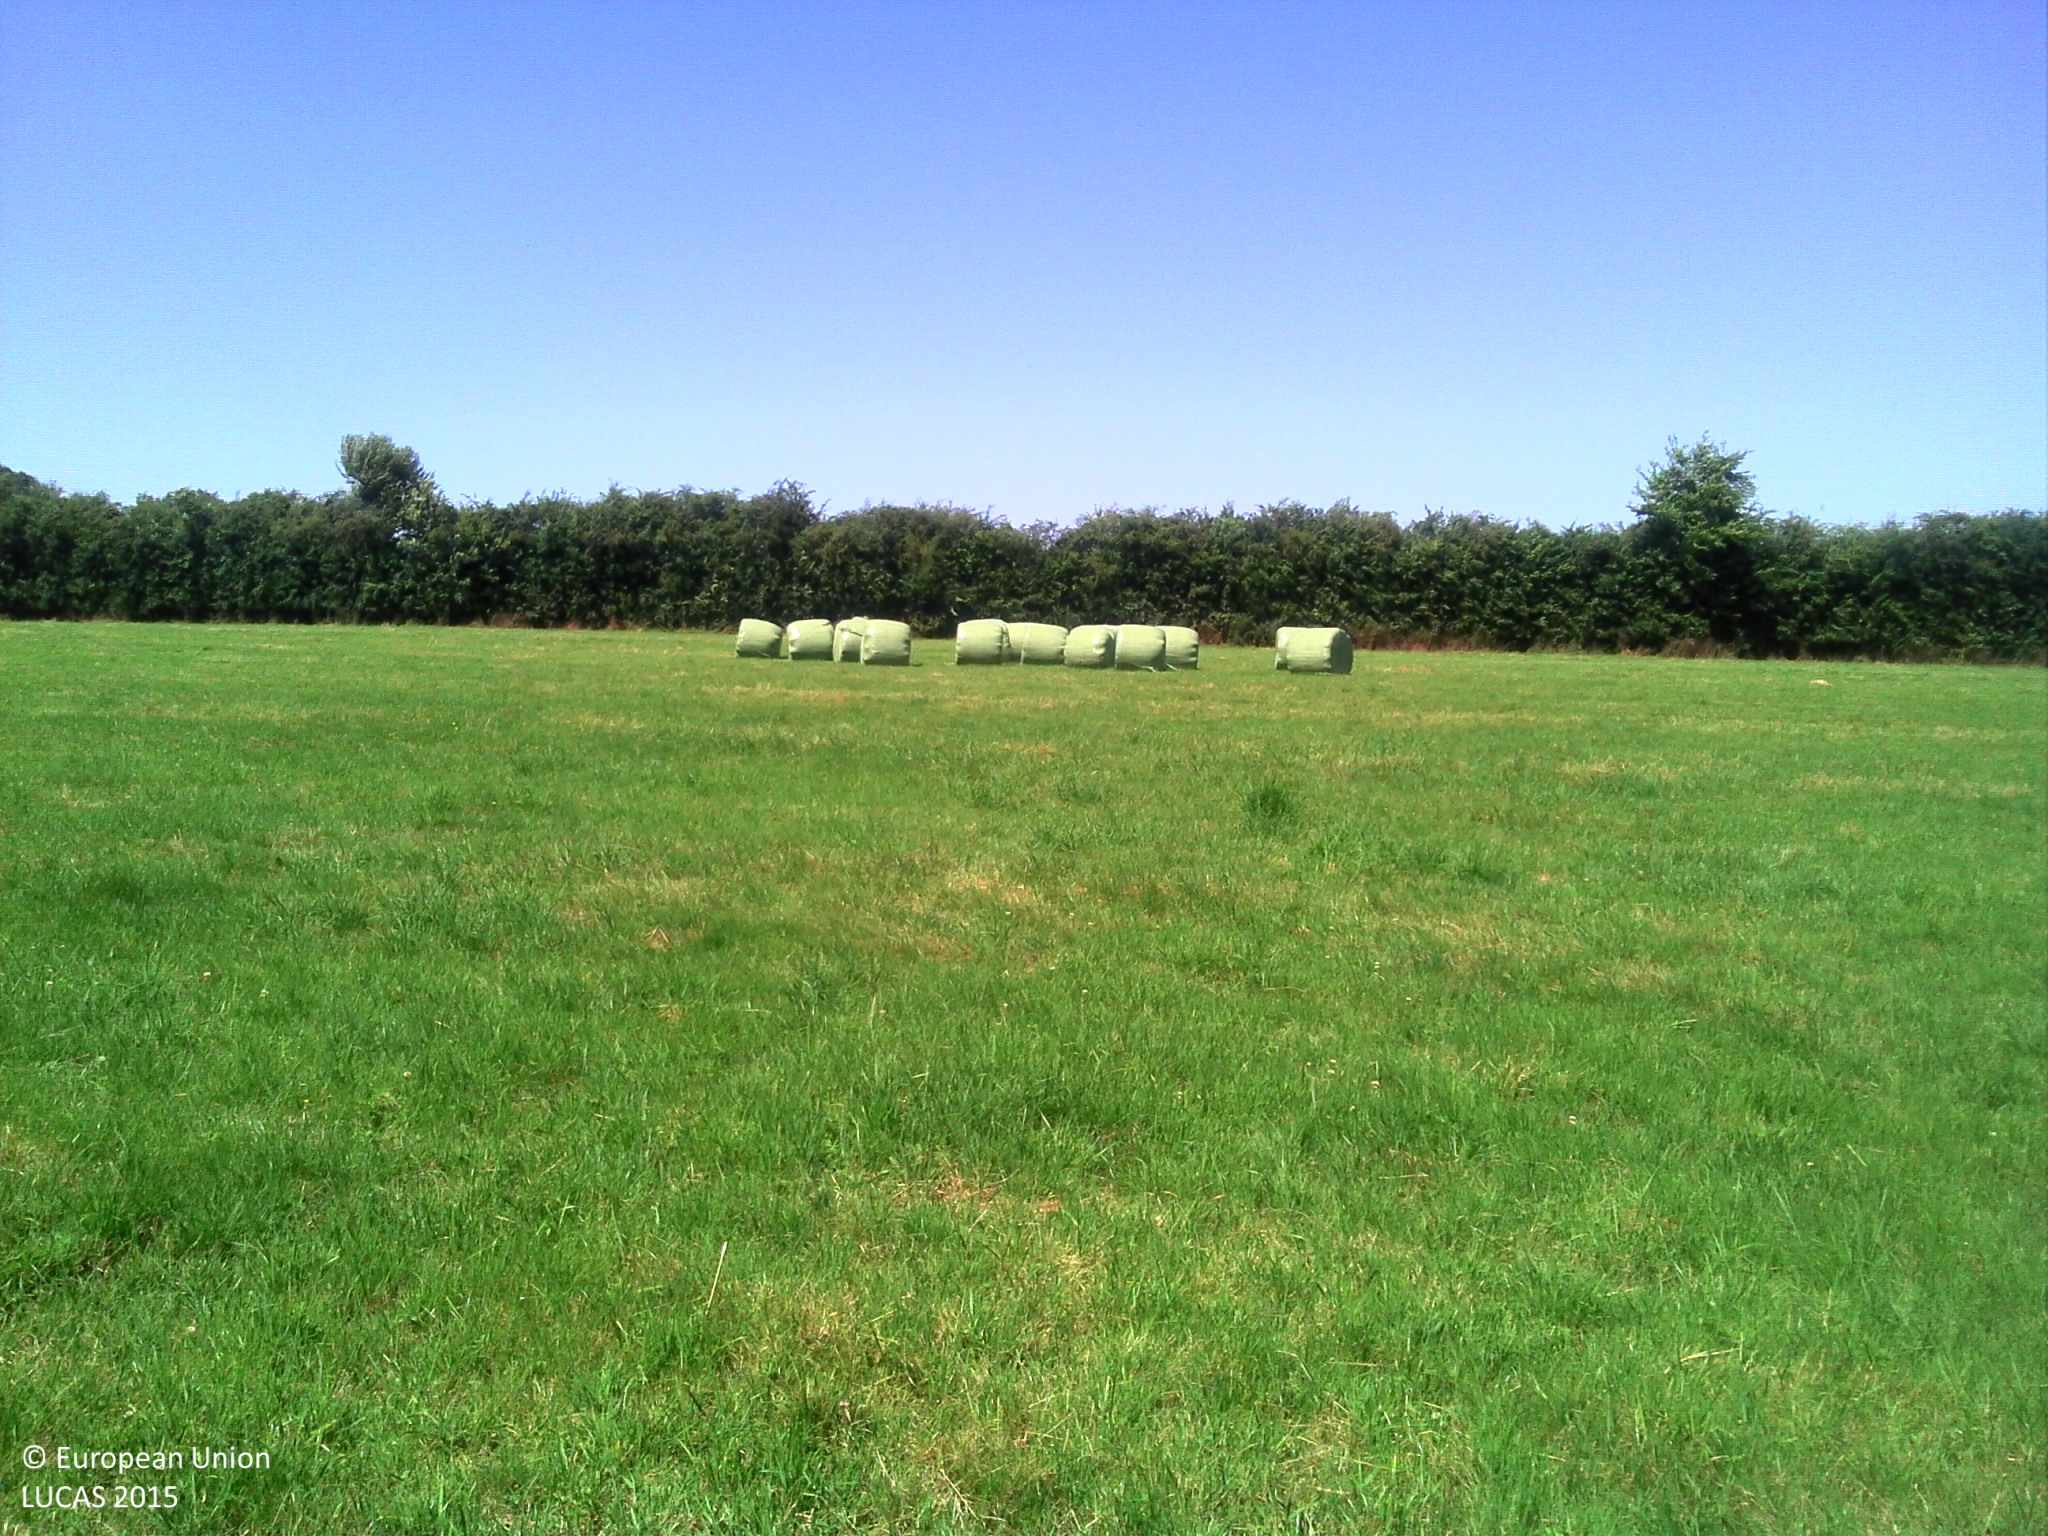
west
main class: Grassland
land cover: Grassland without tree/shrub cover
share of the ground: > 75 %
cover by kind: herbaceous plants 100 %
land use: Agriculture (excluding fallow land and kitchen gardens)
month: July
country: FR
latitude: 49.0521
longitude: 0.3810
